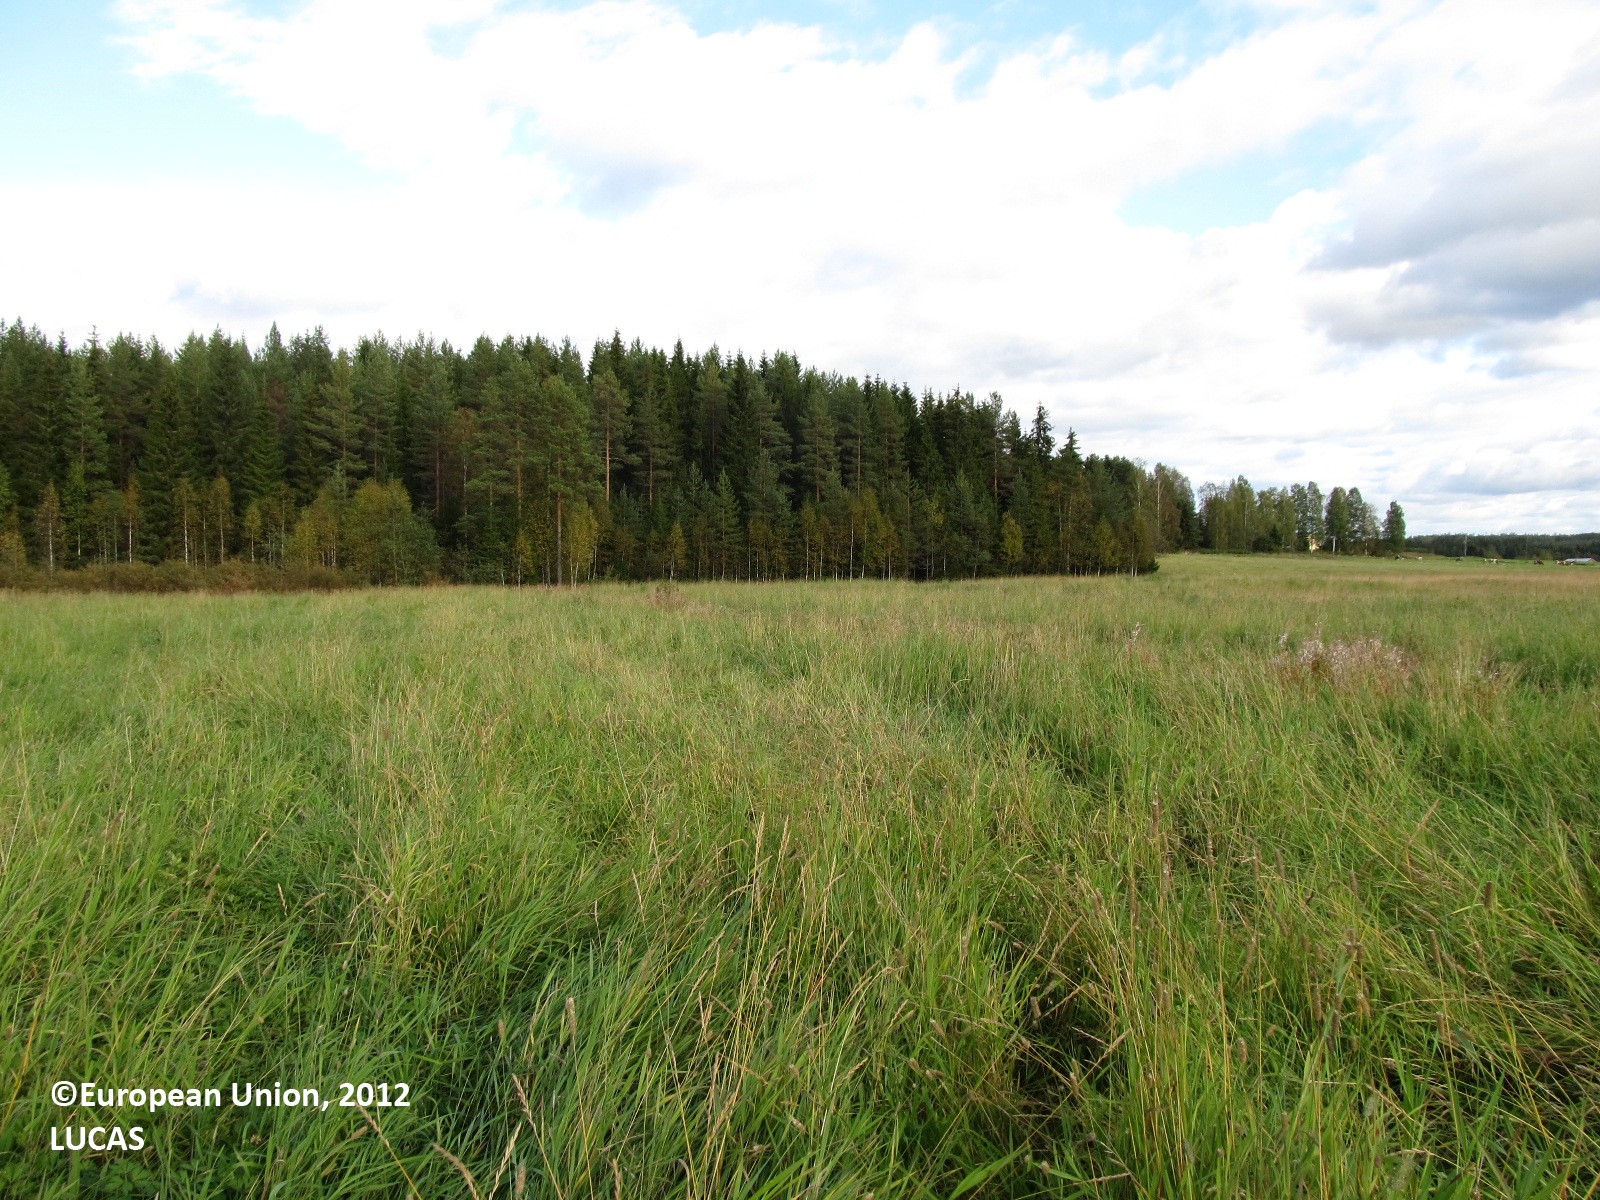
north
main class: Cropland
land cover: Temporary grasslands
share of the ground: > 75 %
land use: Agriculture (excluding fallow land and kitchen gardens)
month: September
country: FI
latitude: 63.2711
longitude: 28.3828
